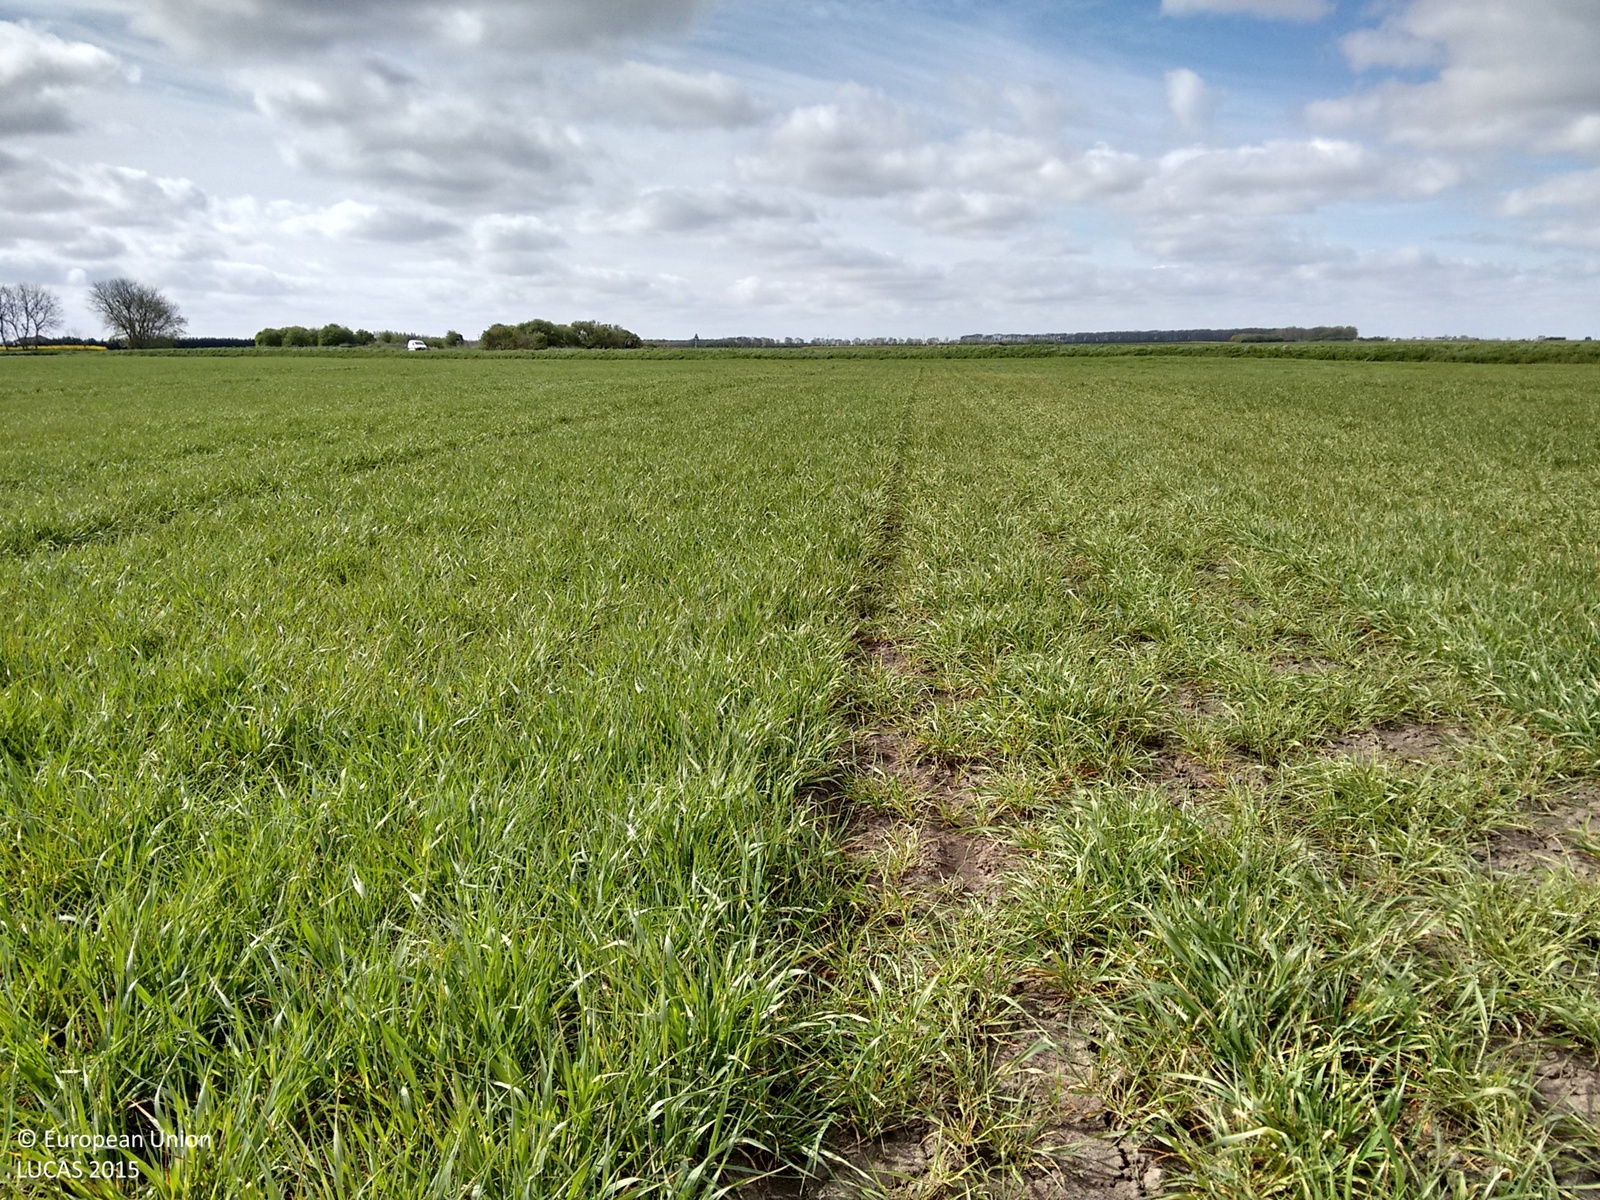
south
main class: Cropland
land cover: Barley
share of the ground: 50 - 75 %
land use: Agriculture (excluding fallow land and kitchen gardens)
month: May
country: GB
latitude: 53.1264
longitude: 0.1511
